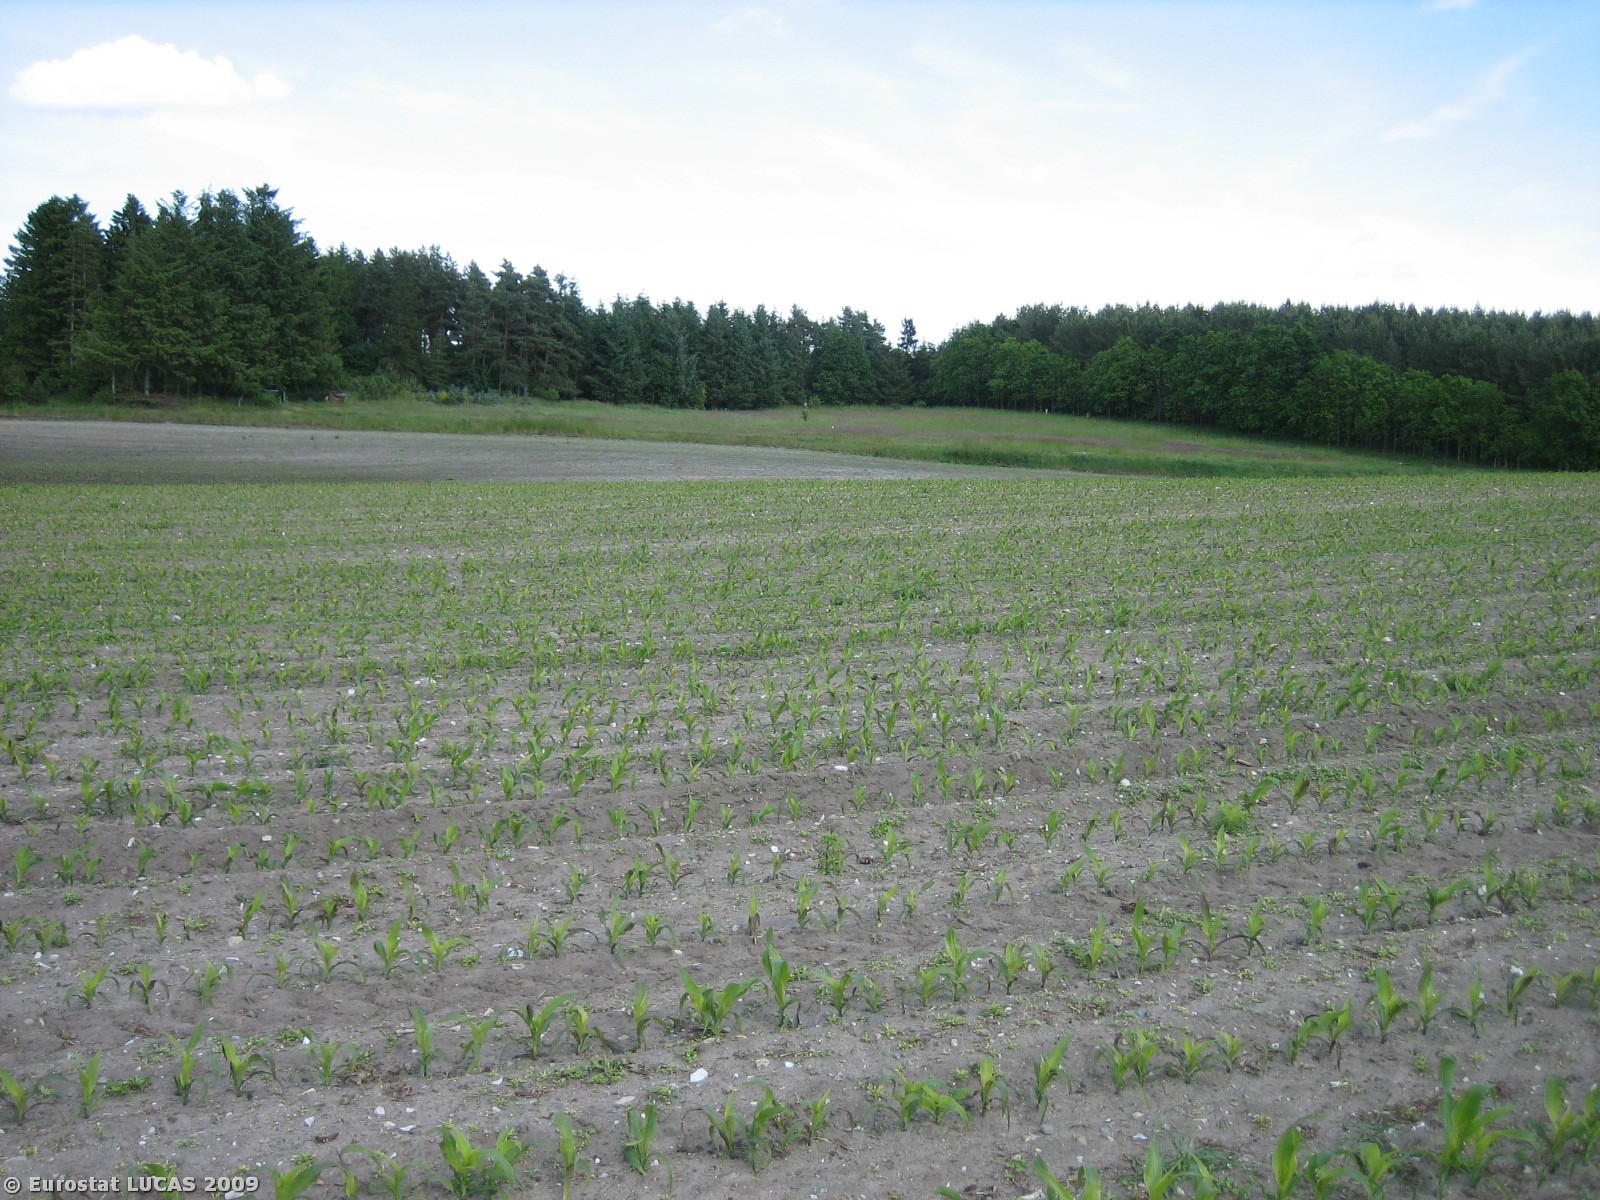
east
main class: Cropland
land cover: Maize
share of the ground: < 10 %
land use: Agriculture (excluding fallow land and kitchen gardens)
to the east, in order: Maize; Grassland without tree/shrub cover; Tracks; Grassland without tree/shrub cover; Tracks; Grassland without tree/shrub cover; Coniferous woodland
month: June
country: DK
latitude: 56.0079
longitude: 9.8558
